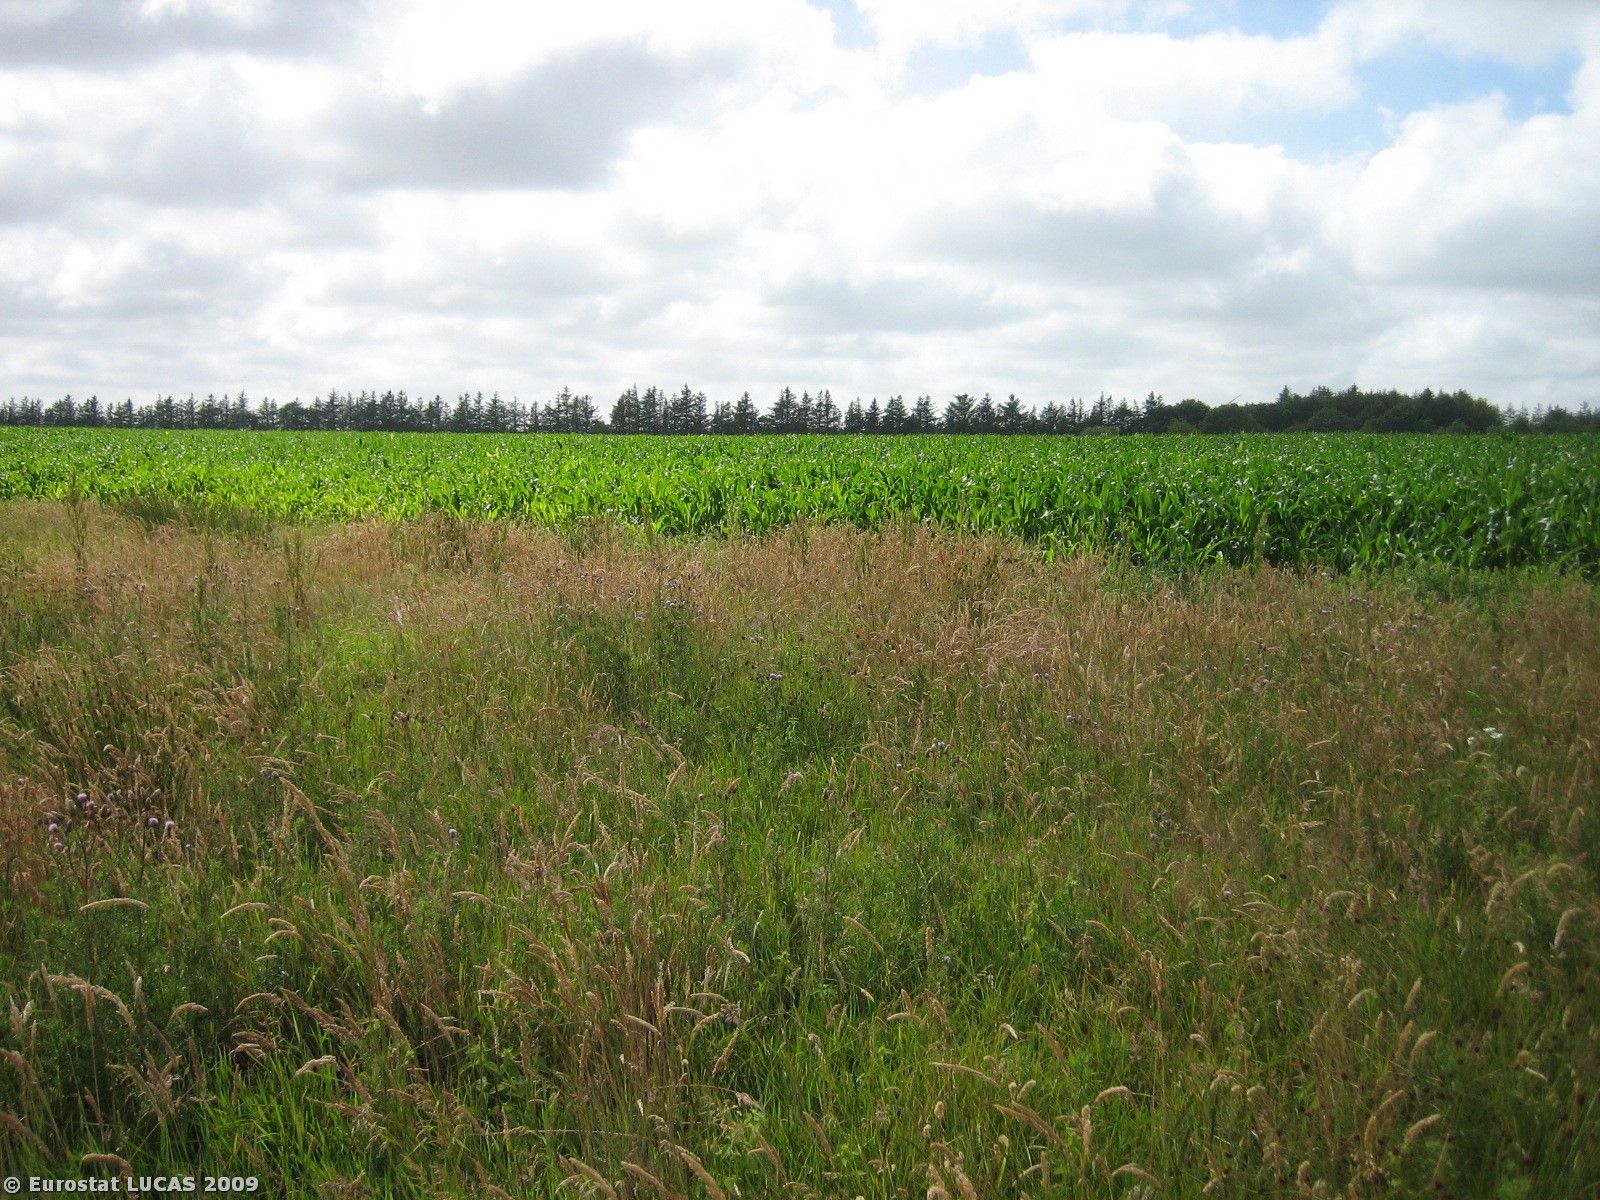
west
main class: Grassland
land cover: Grassland without tree/shrub cover
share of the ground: > 75 %
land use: Unused
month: July
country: DK
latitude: 55.6747
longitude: 8.4272
